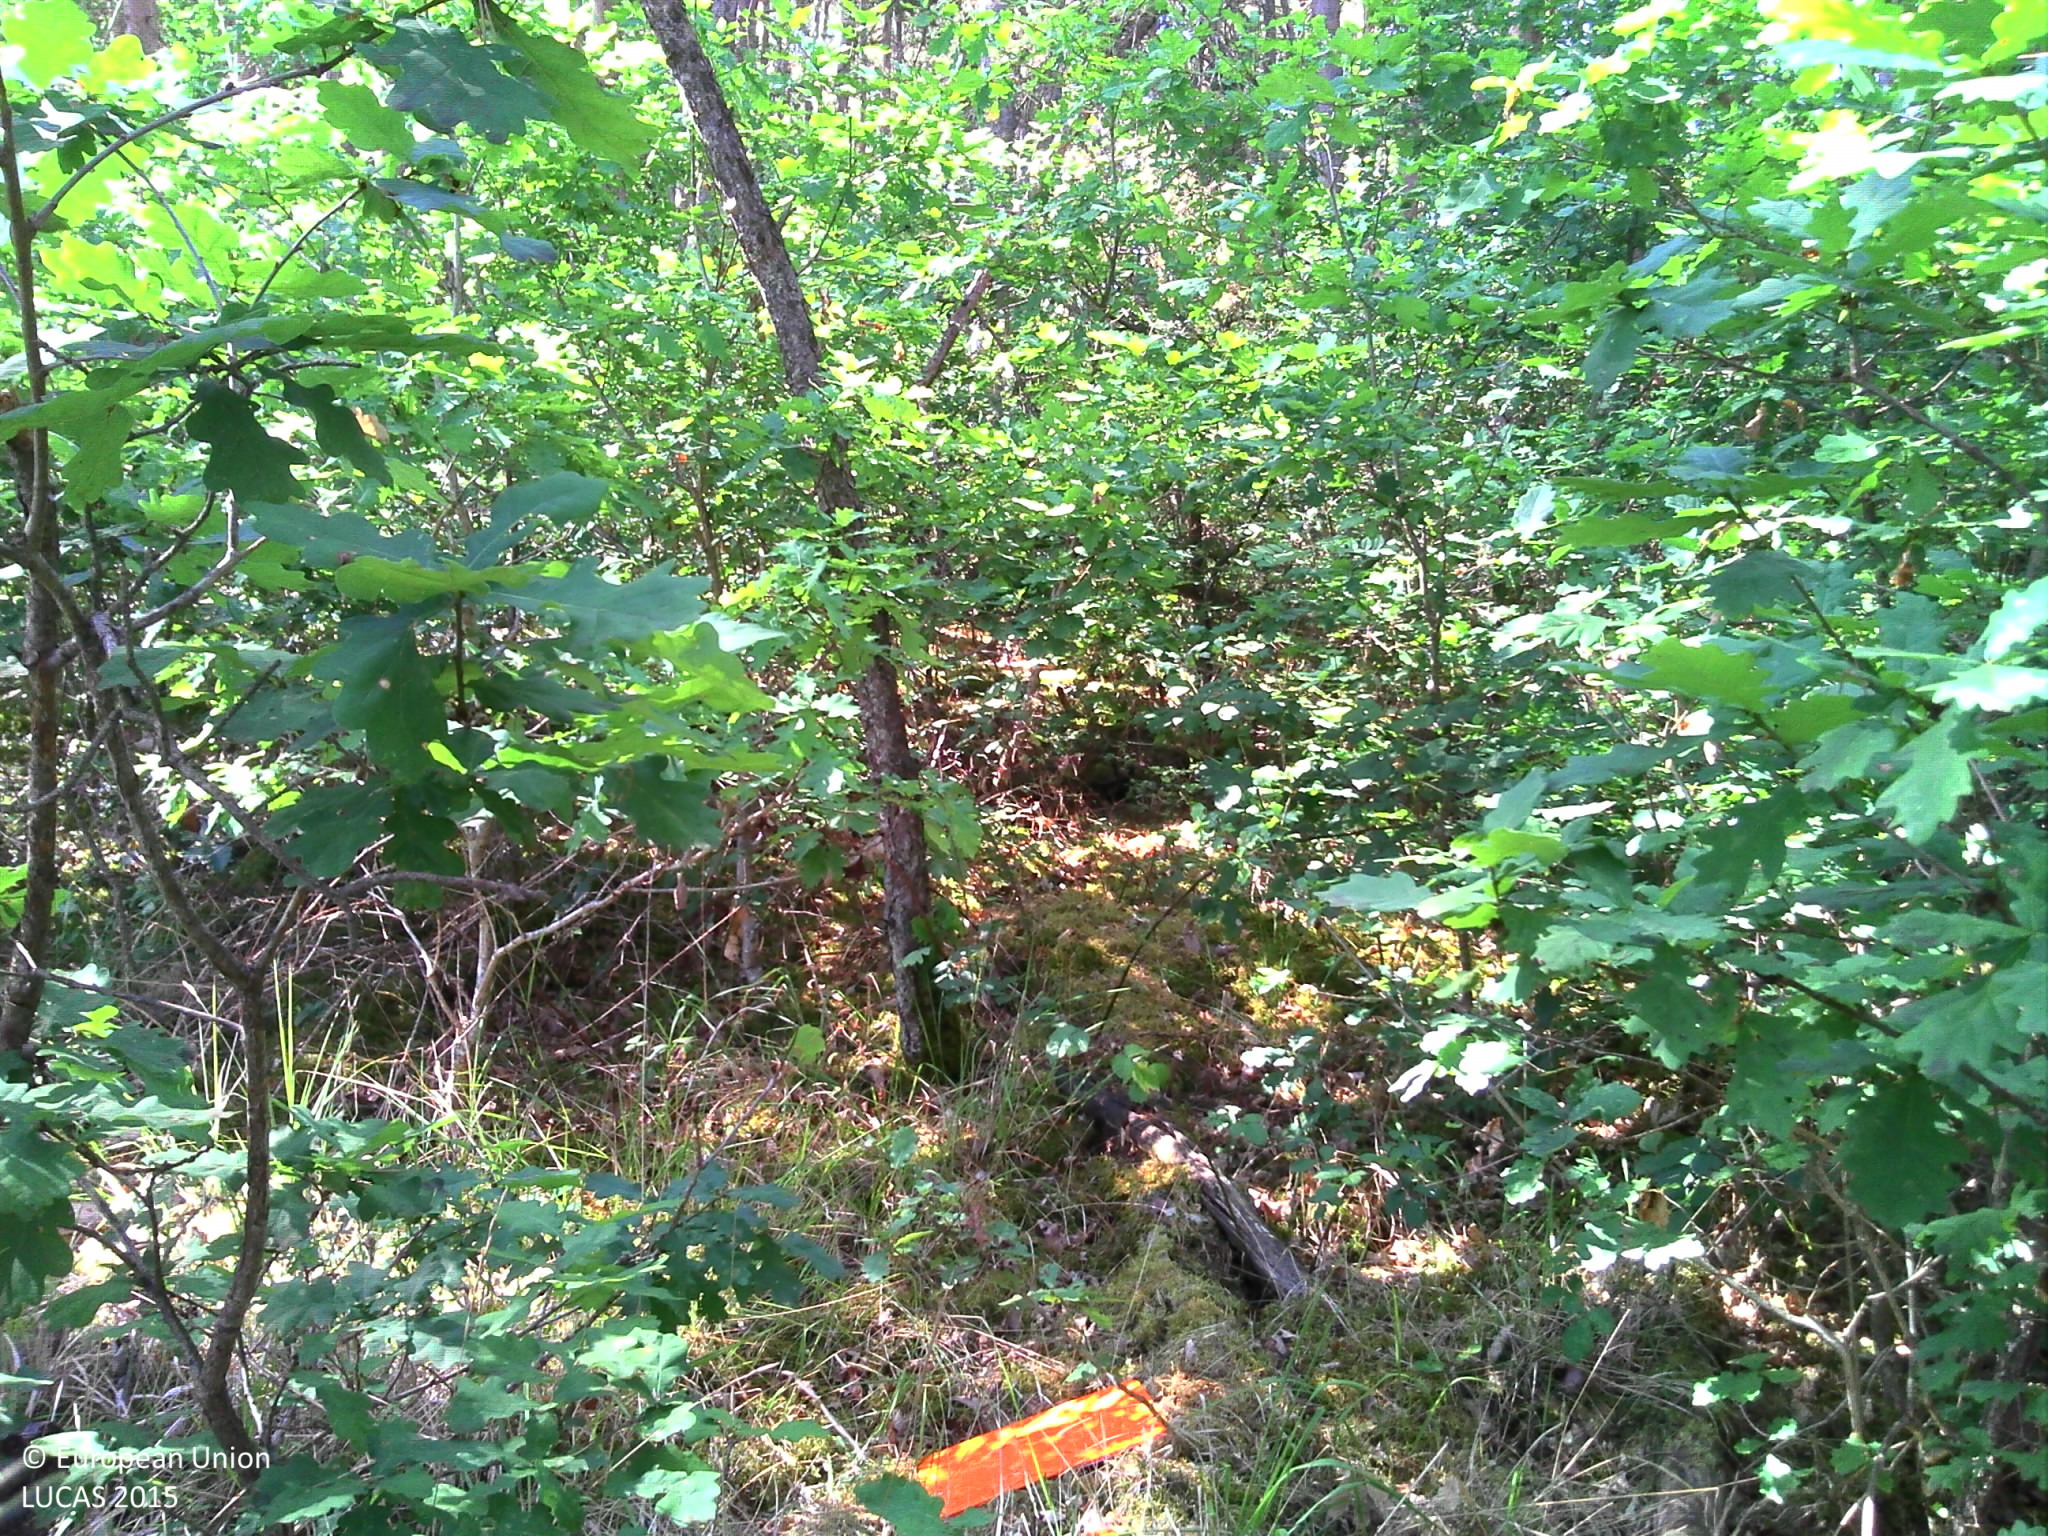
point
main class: Woodland
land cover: Pine dominated mixed woodland
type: acidophilous oak and oak-birch forest
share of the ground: > 75 %
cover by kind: coniferous forest trees 75 %, broadleaved forest trees 25 %
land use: Forestry
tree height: > 5 m
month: July
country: FR
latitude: 45.2836
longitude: 3.4622
